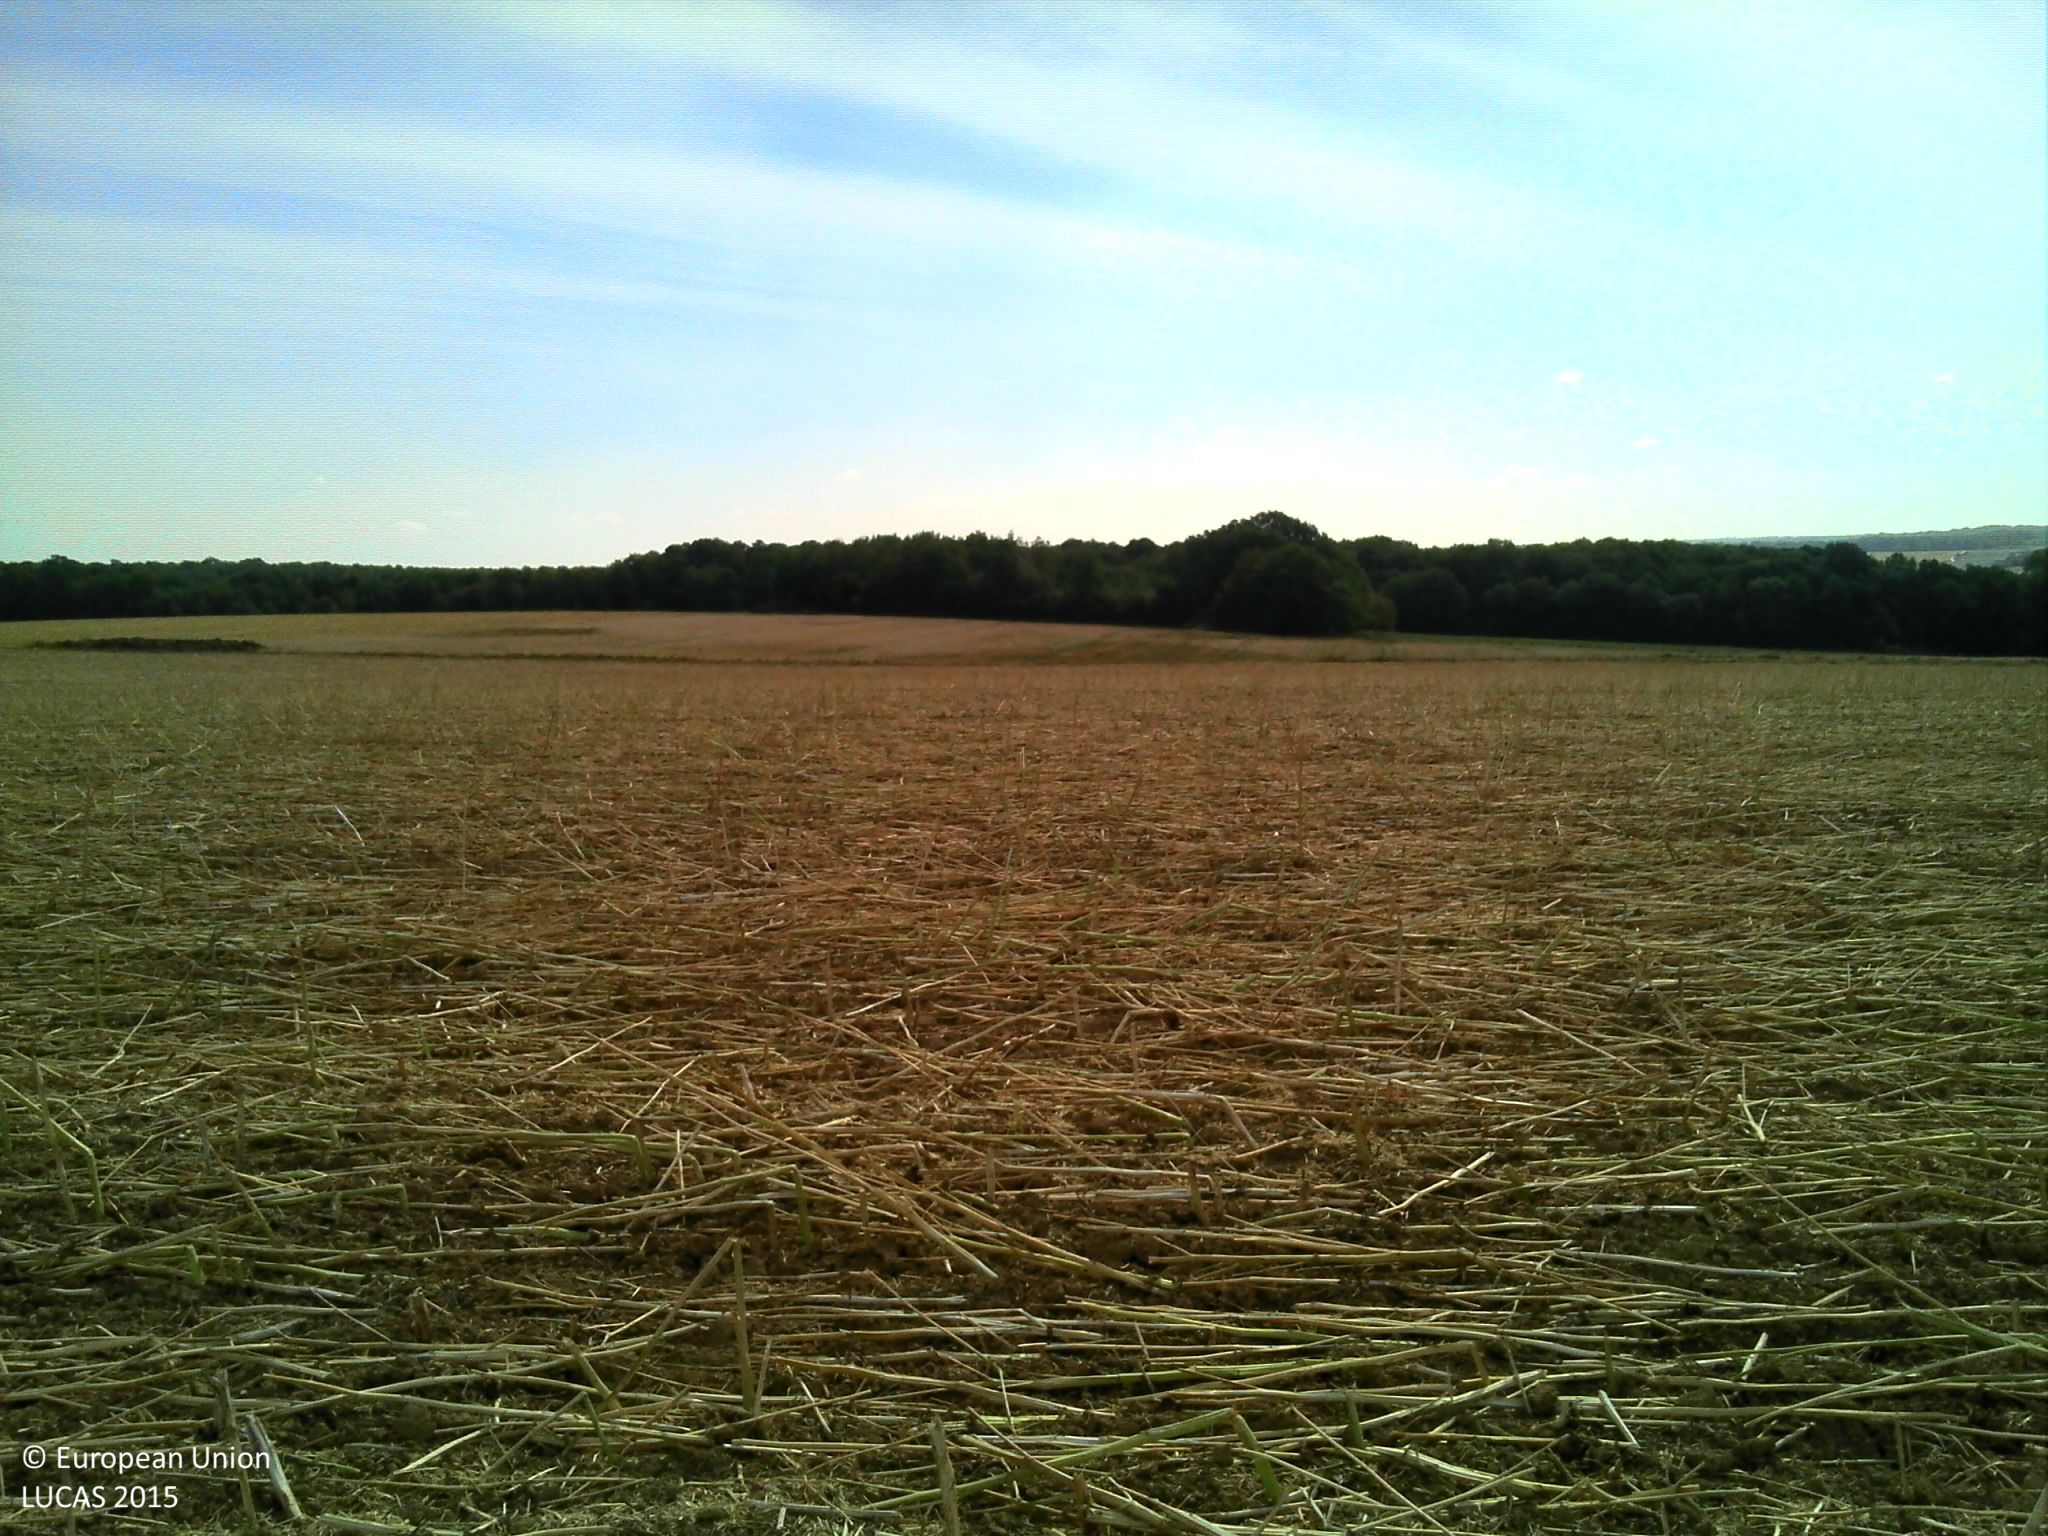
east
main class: Cropland
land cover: Rape and turnip rape
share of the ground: > 75 %
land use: Agriculture (excluding fallow land and kitchen gardens)
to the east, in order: Rape and turnip rape; Grass margins; Tracks; Grass margins; Rape and turnip rape
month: August
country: FR
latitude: 49.0531
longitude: 3.6859
